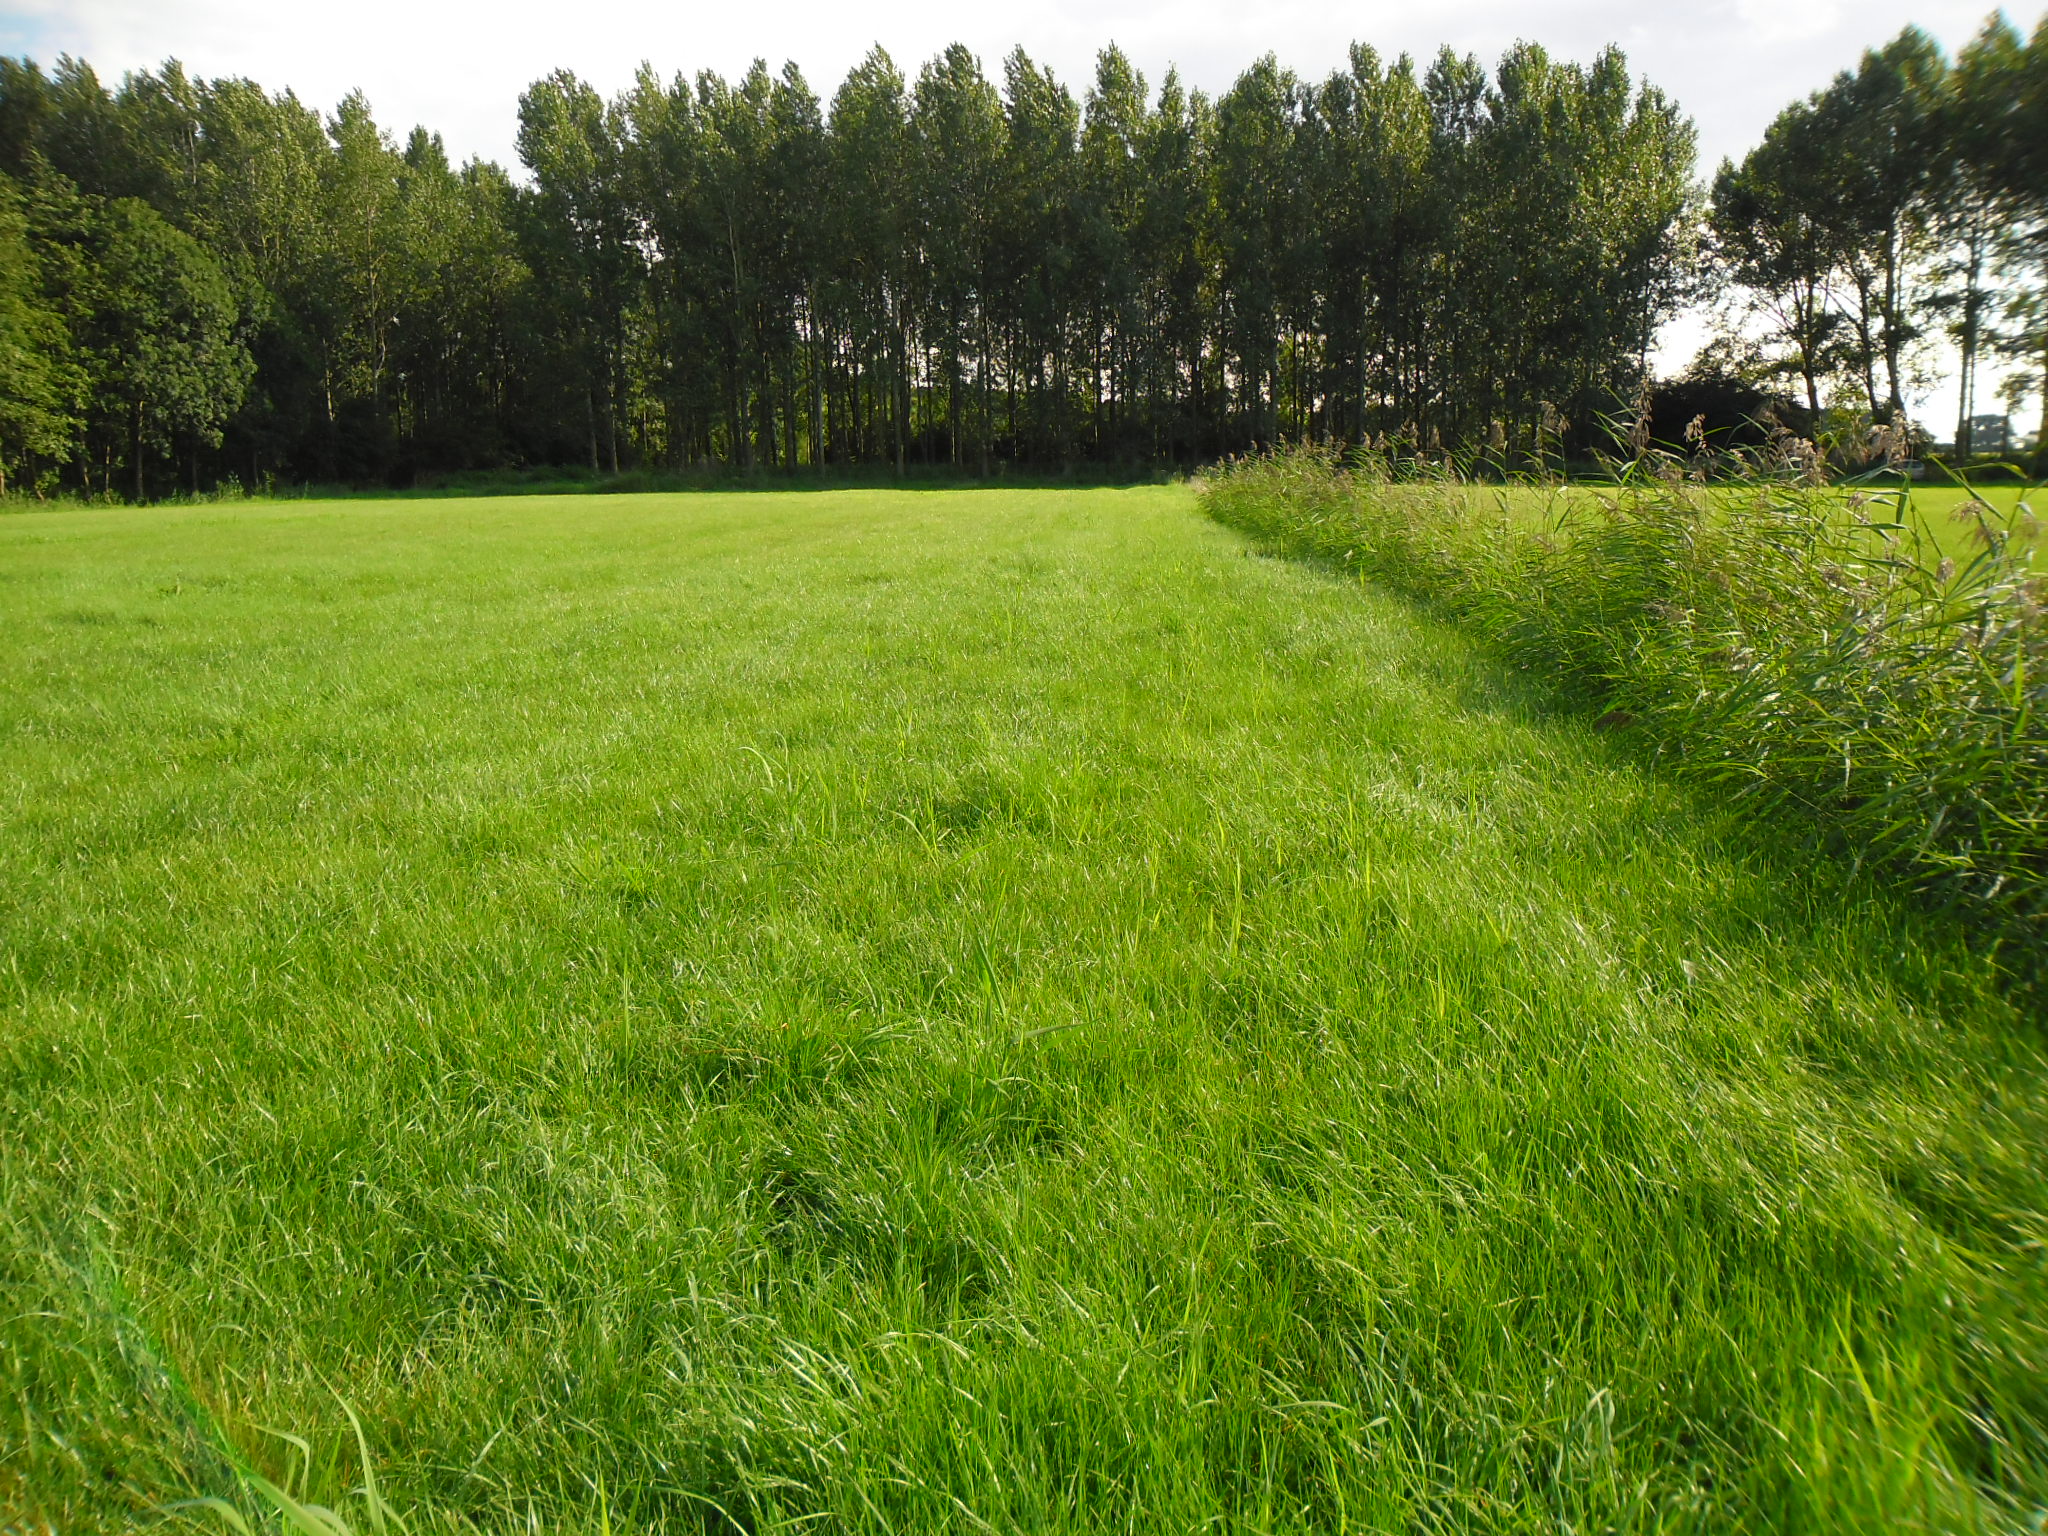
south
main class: Grassland
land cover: Grassland without tree/shrub cover
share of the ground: > 75 %
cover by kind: herbaceous plants 100 %
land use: Agriculture (excluding fallow land and kitchen gardens)
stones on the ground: < 10 %
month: September
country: NL
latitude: 52.0834
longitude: 6.2198
